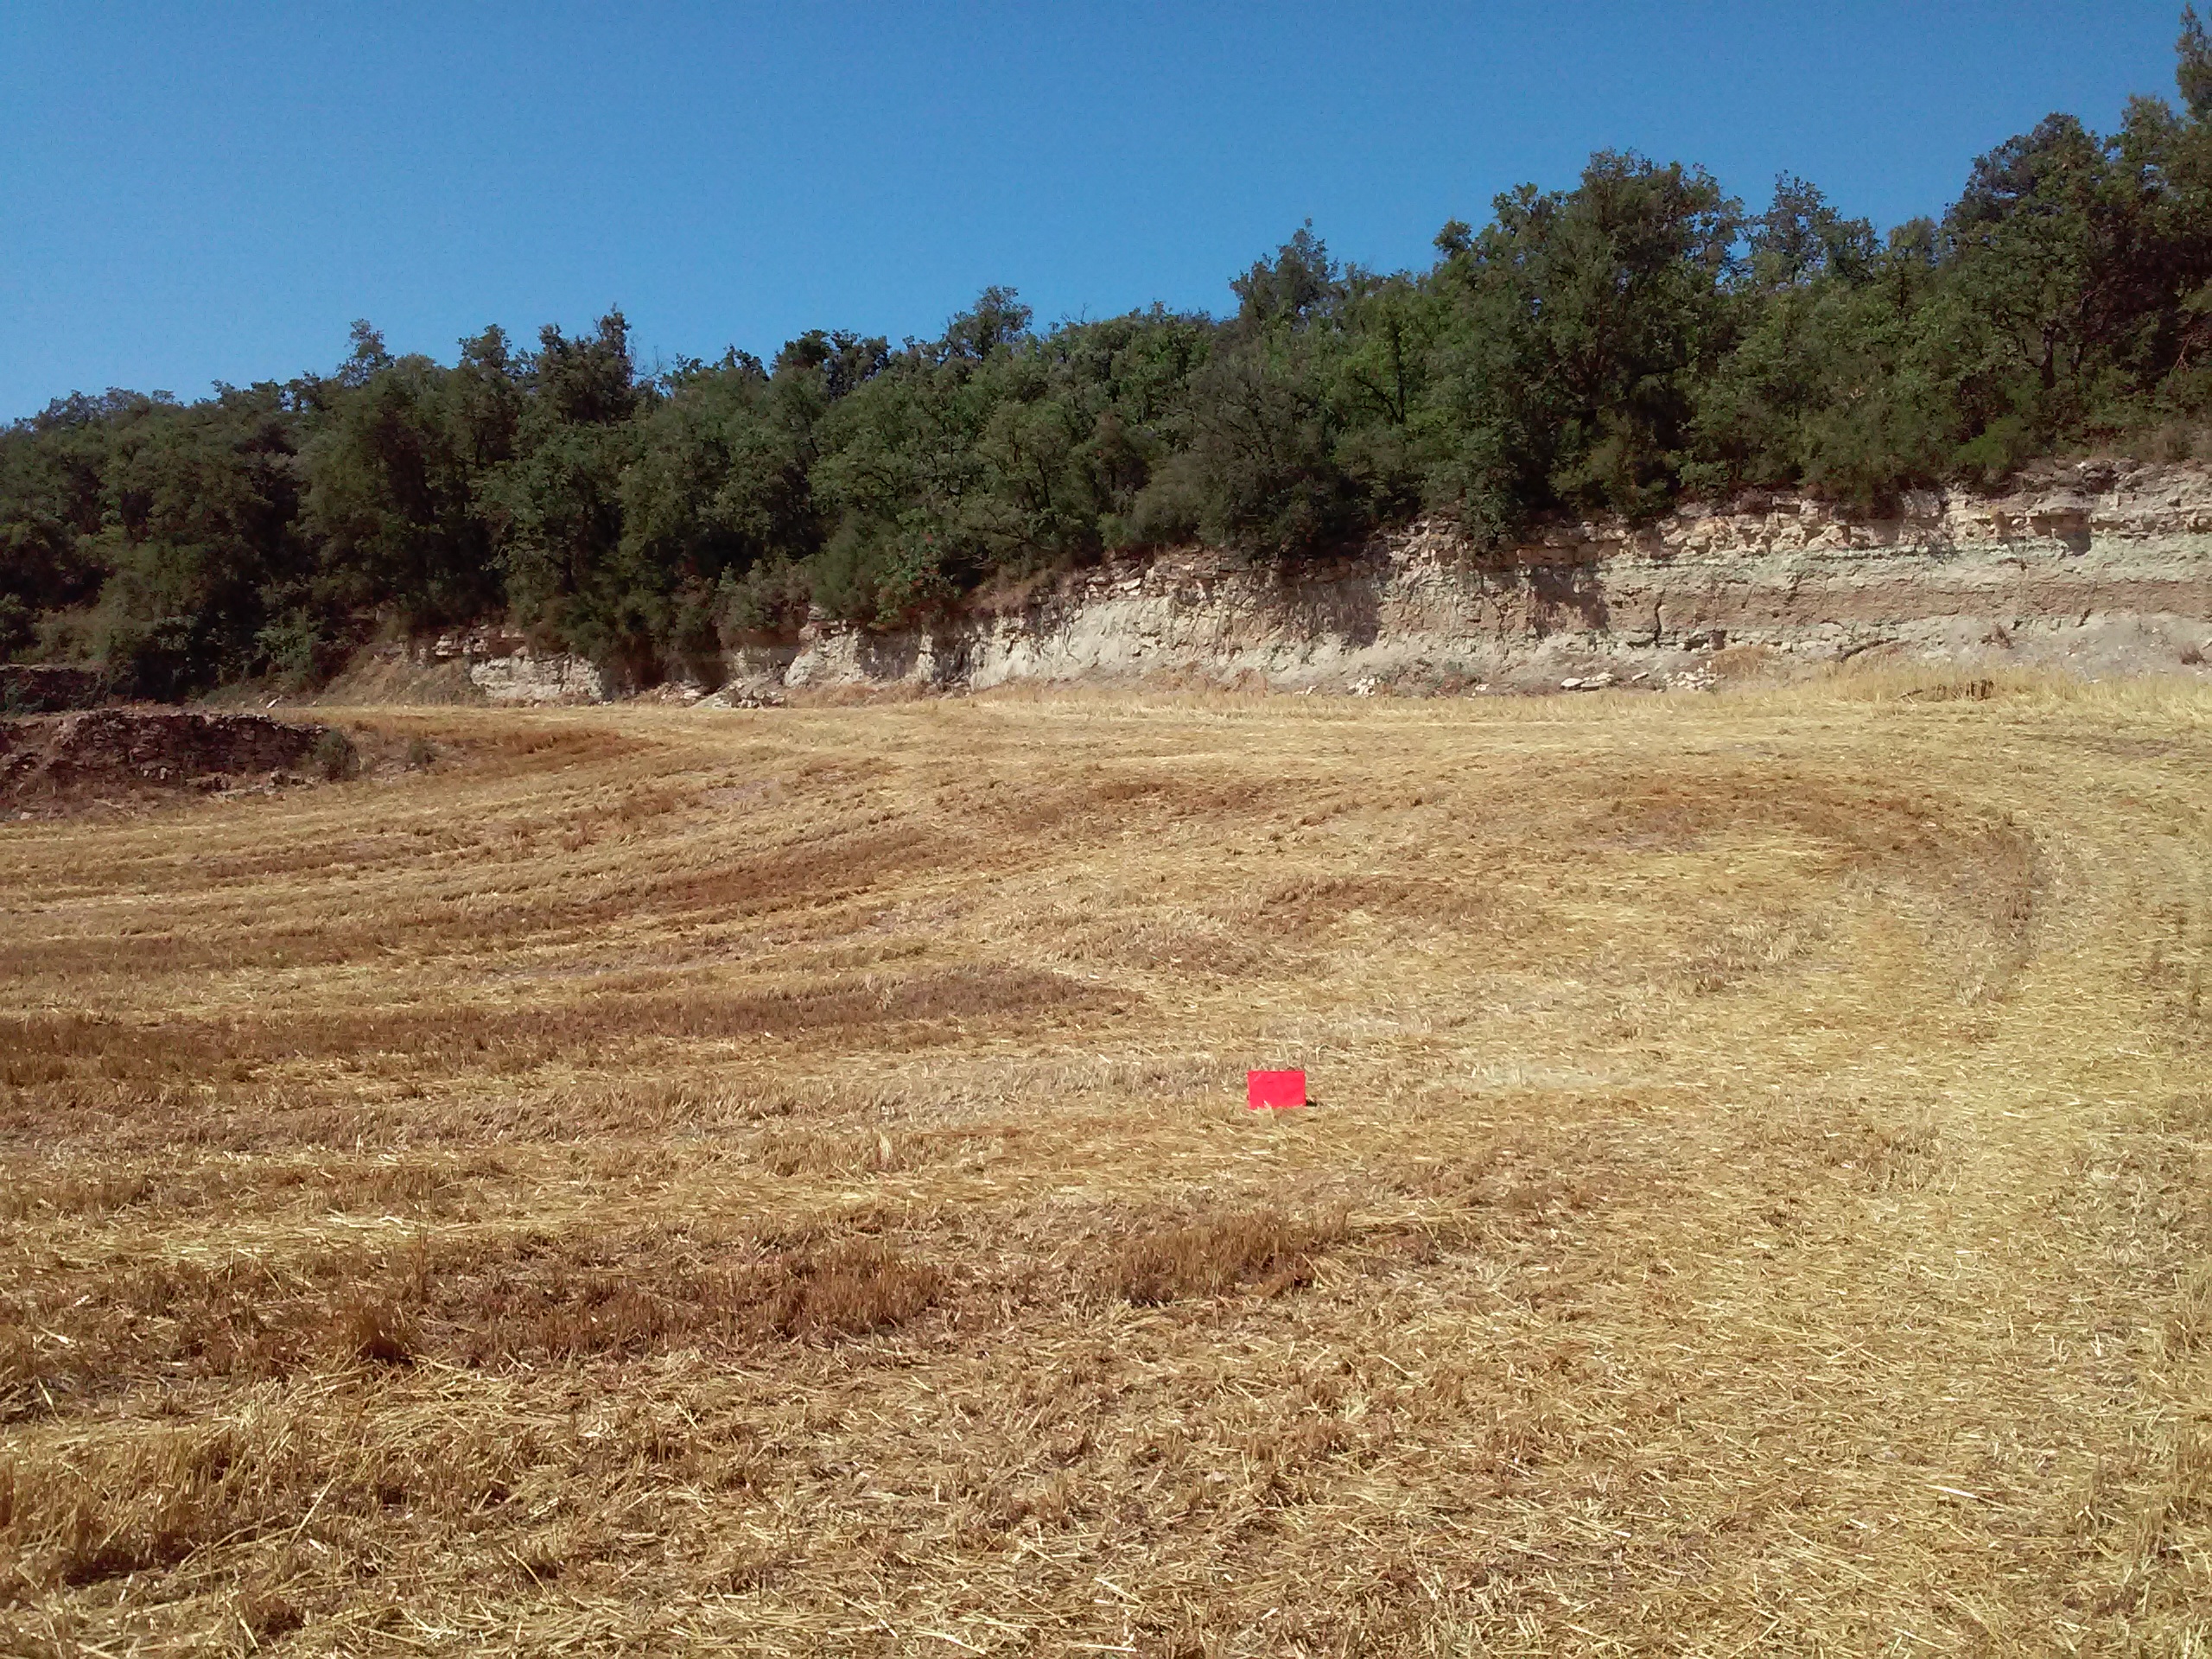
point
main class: Cropland
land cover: Barley
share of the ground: < 10 %
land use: Agriculture (excluding fallow land and kitchen gardens)
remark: Harvested field
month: July
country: ES
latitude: 41.5822
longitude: 1.2223
